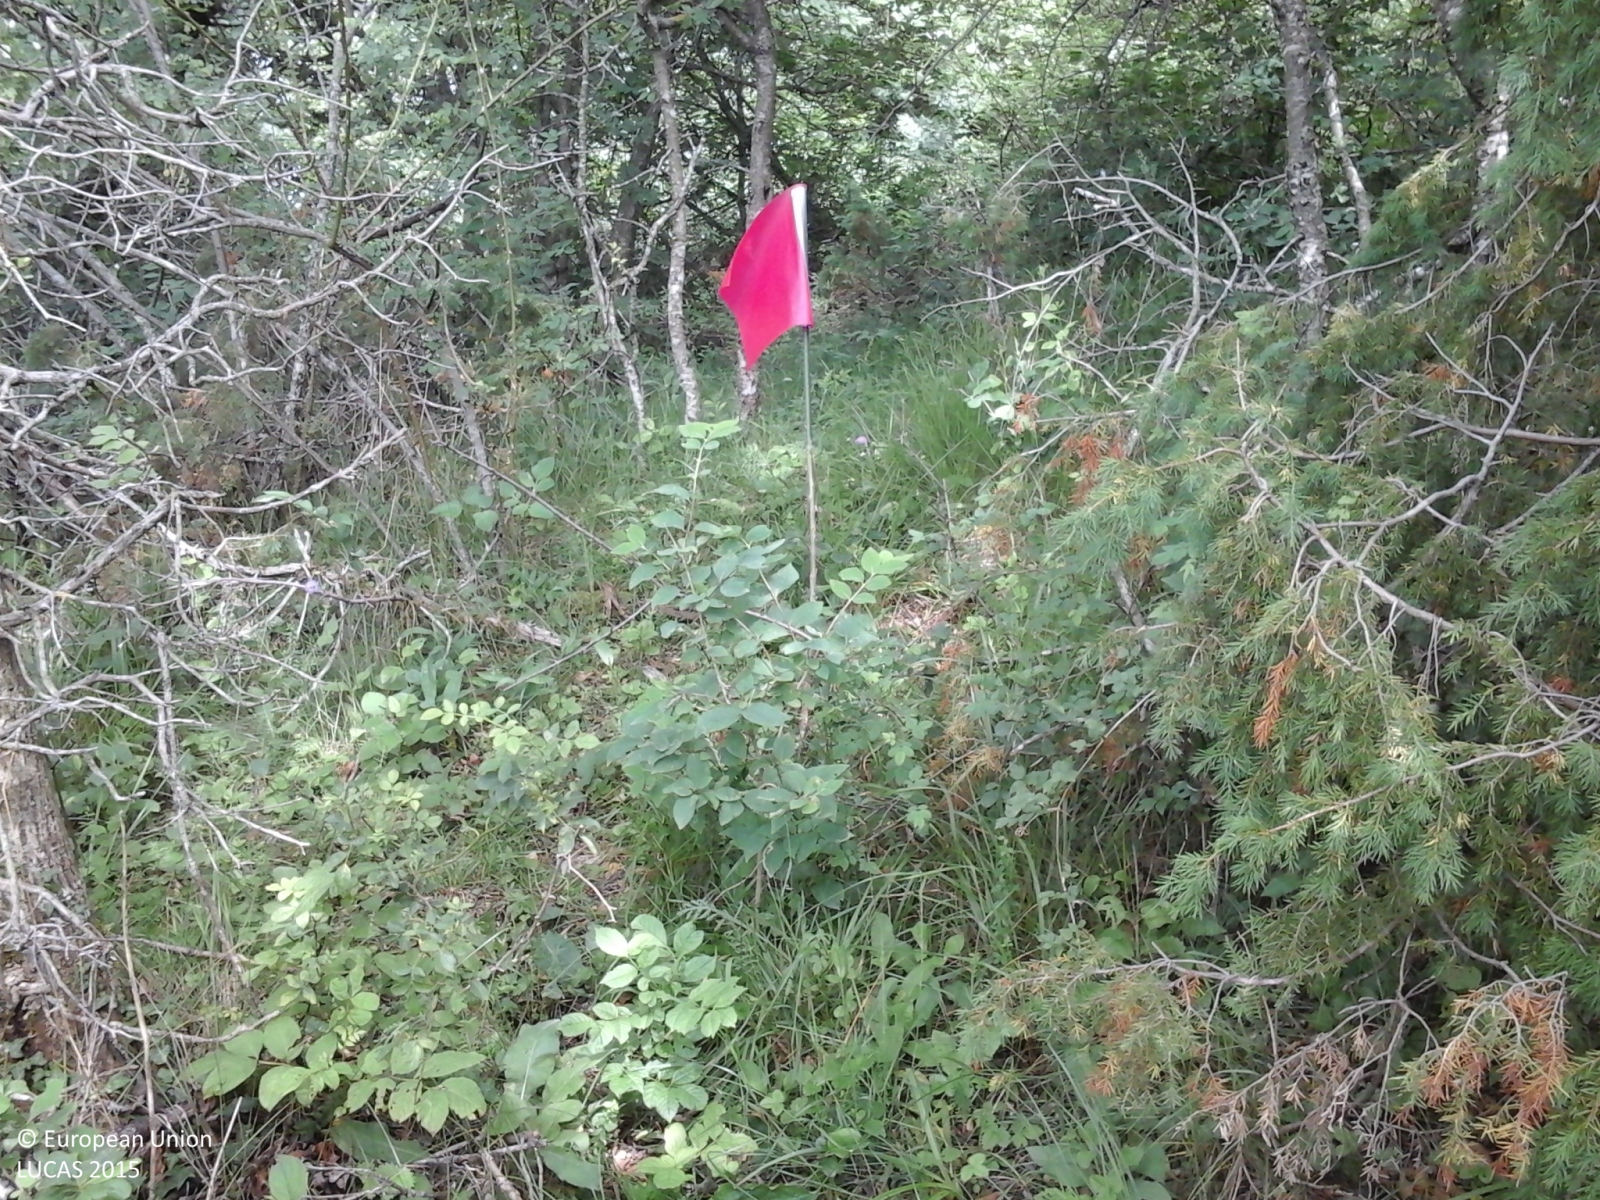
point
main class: Woodland
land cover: Broadleaved woodland
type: mesophytic deciduous forest
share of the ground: > 75 %
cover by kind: broadleaved forest trees 100 %
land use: Semi-natural and natural areas not in use
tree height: > 5 m
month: June
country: IT
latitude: 46.0177
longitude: 12.4123
